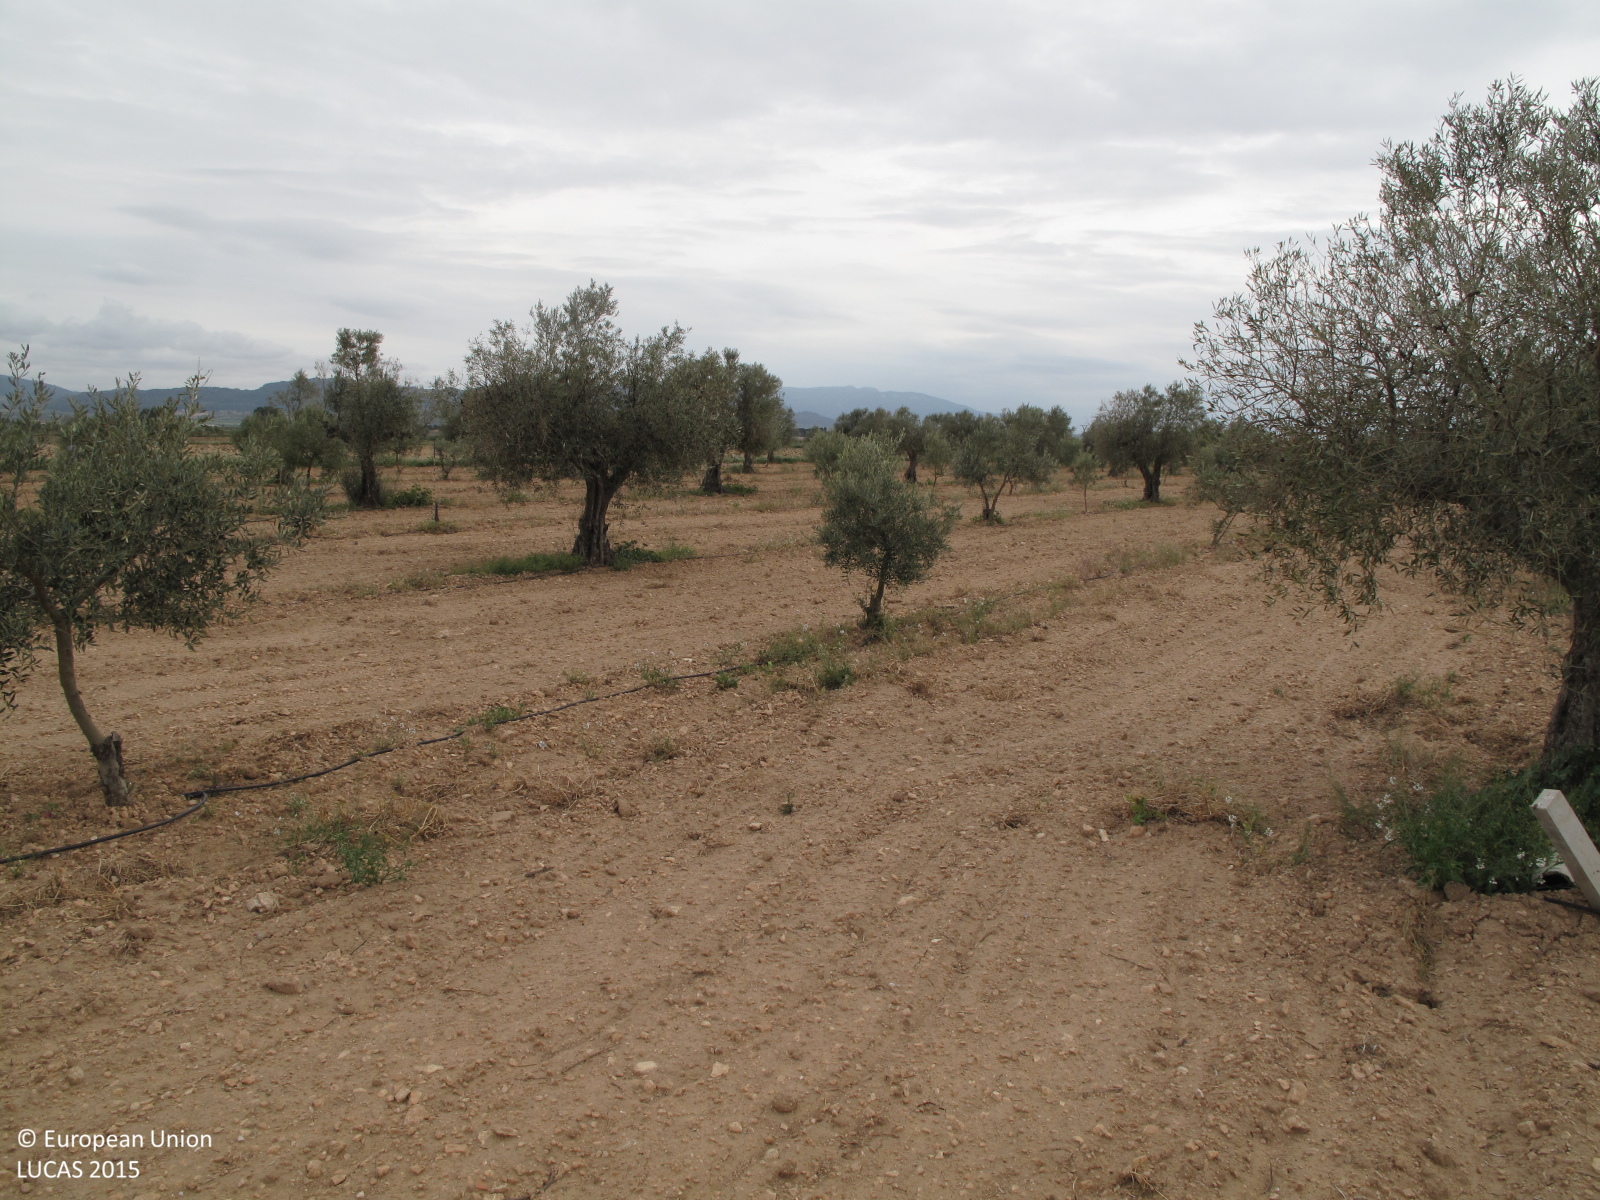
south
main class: Cropland
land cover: Olive groves
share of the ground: 10 - 25 %
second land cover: Other bare soil
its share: > 75 %
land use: Agriculture (excluding fallow land and kitchen gardens)
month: April
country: ES
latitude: 38.5980
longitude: -1.0710
